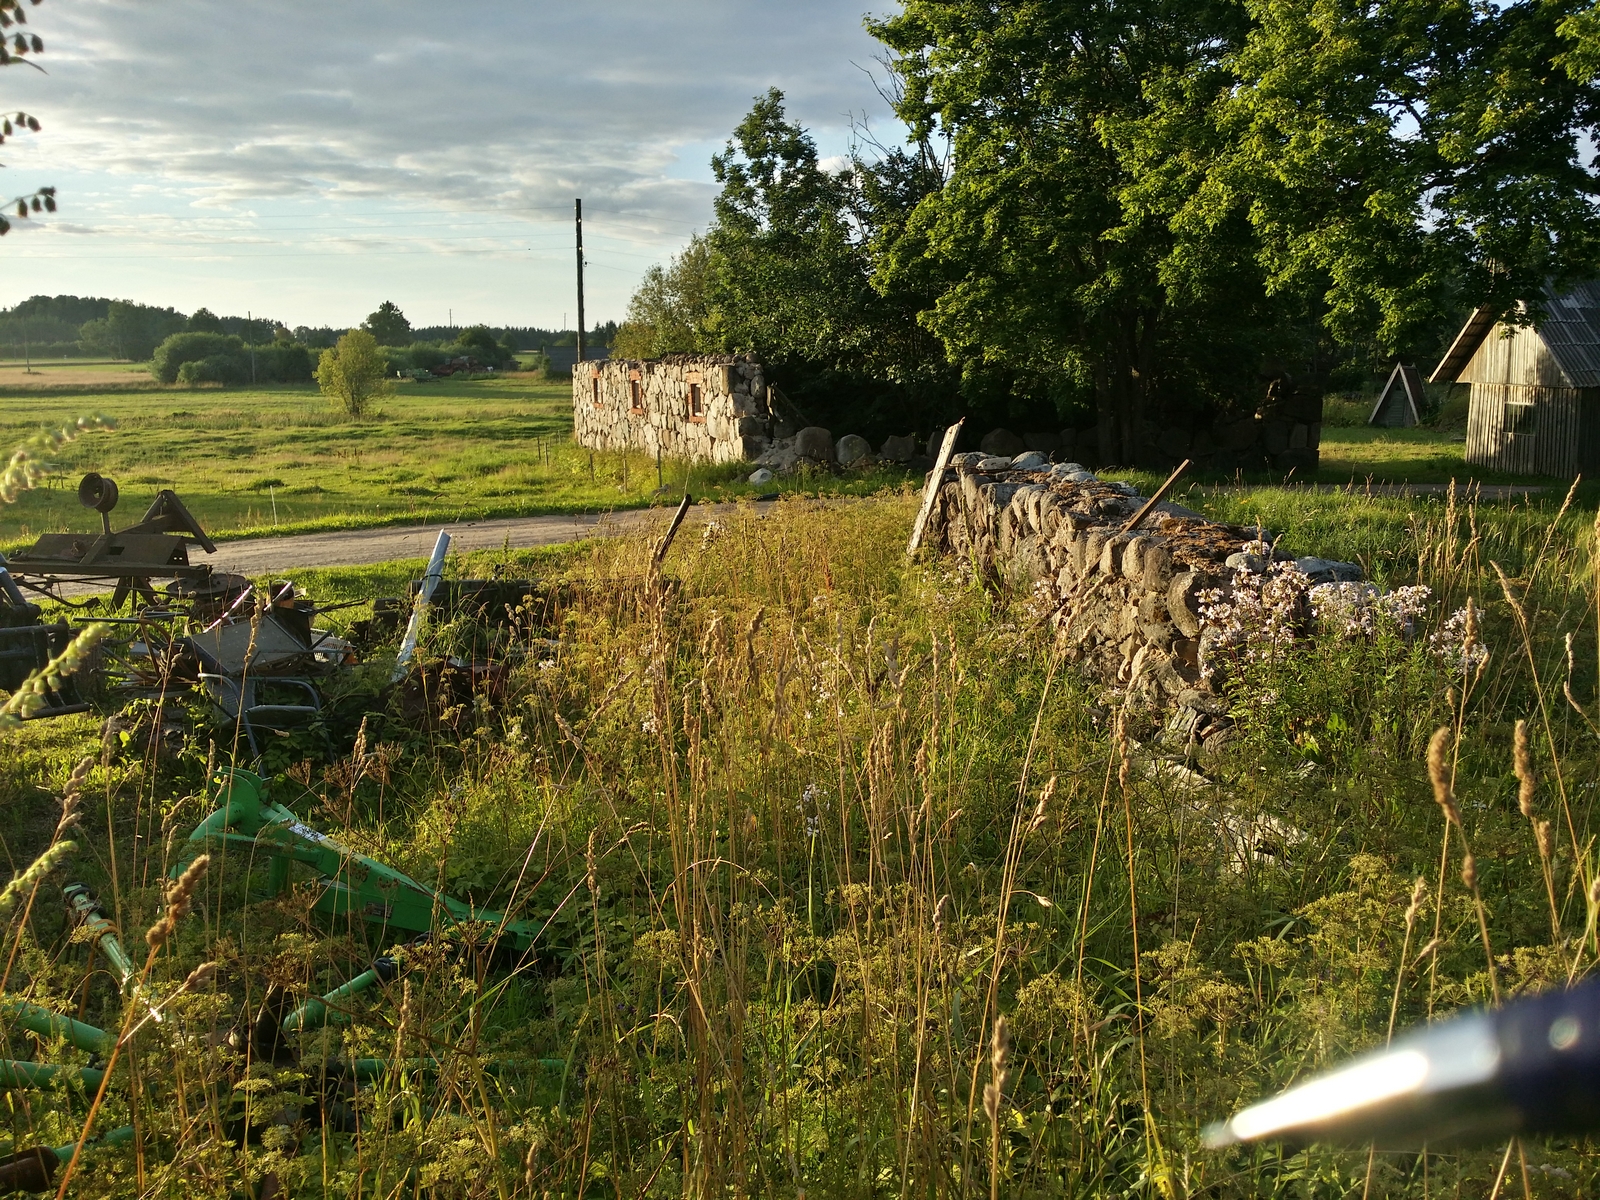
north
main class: Grassland
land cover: Spontaneously vegetated surfaces
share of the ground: > 75 %
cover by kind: herbaceous plants 95 %, shrubs 5 %
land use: Semi-natural and natural areas not in use
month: July
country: LV
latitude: 57.2970
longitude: 26.6607
